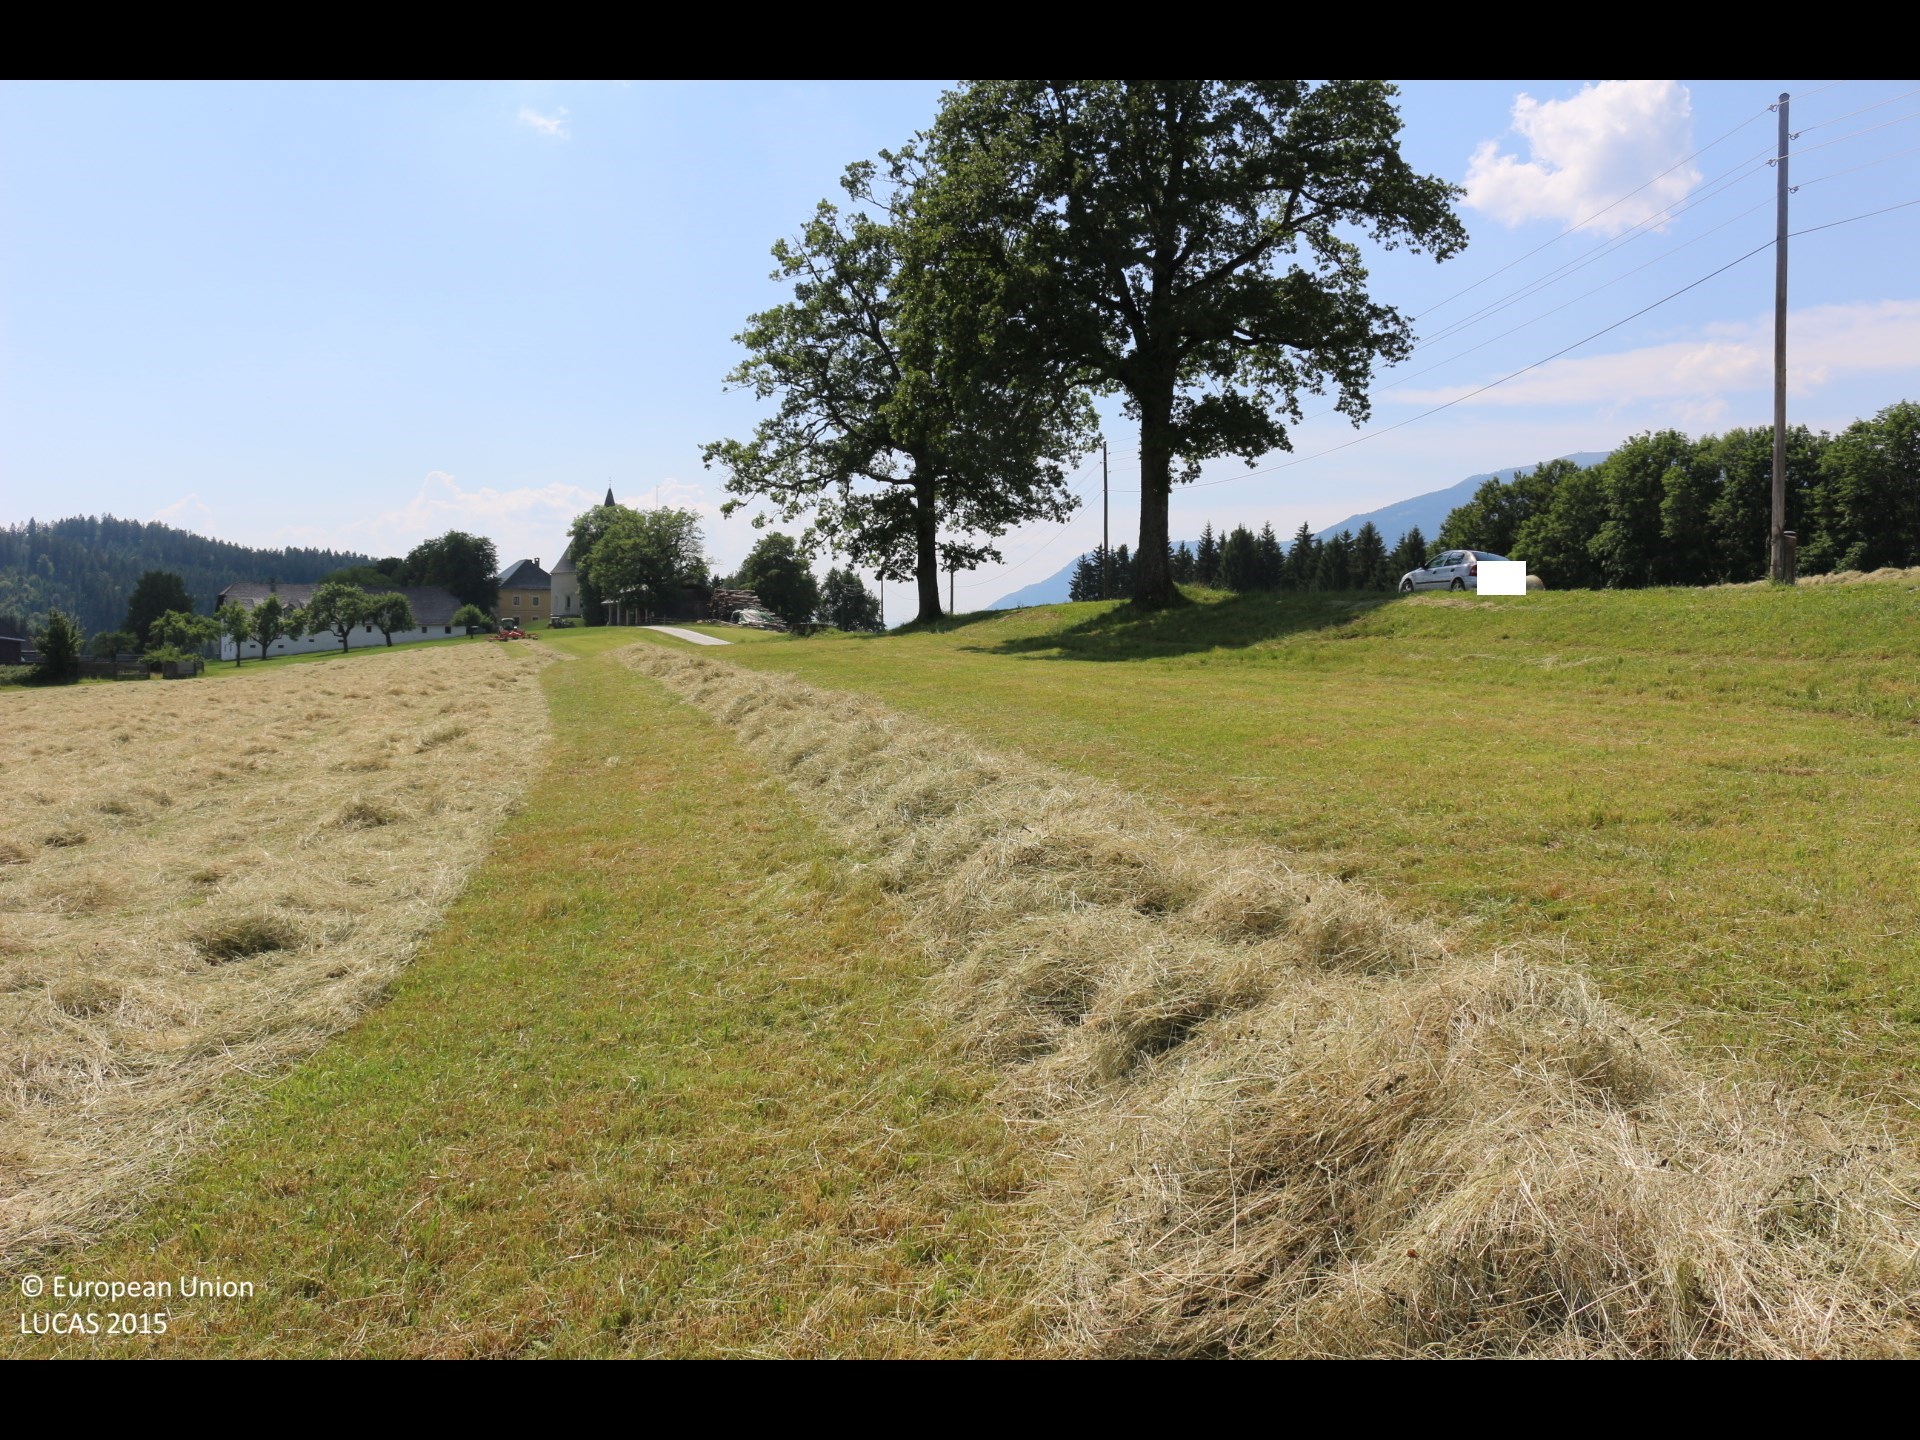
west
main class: Grassland
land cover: Grassland without tree/shrub cover
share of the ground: > 75 %
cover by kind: herbaceous plants 100 %
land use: Agriculture (excluding fallow land and kitchen gardens)
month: June
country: AT
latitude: 46.6727
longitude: 14.0104
